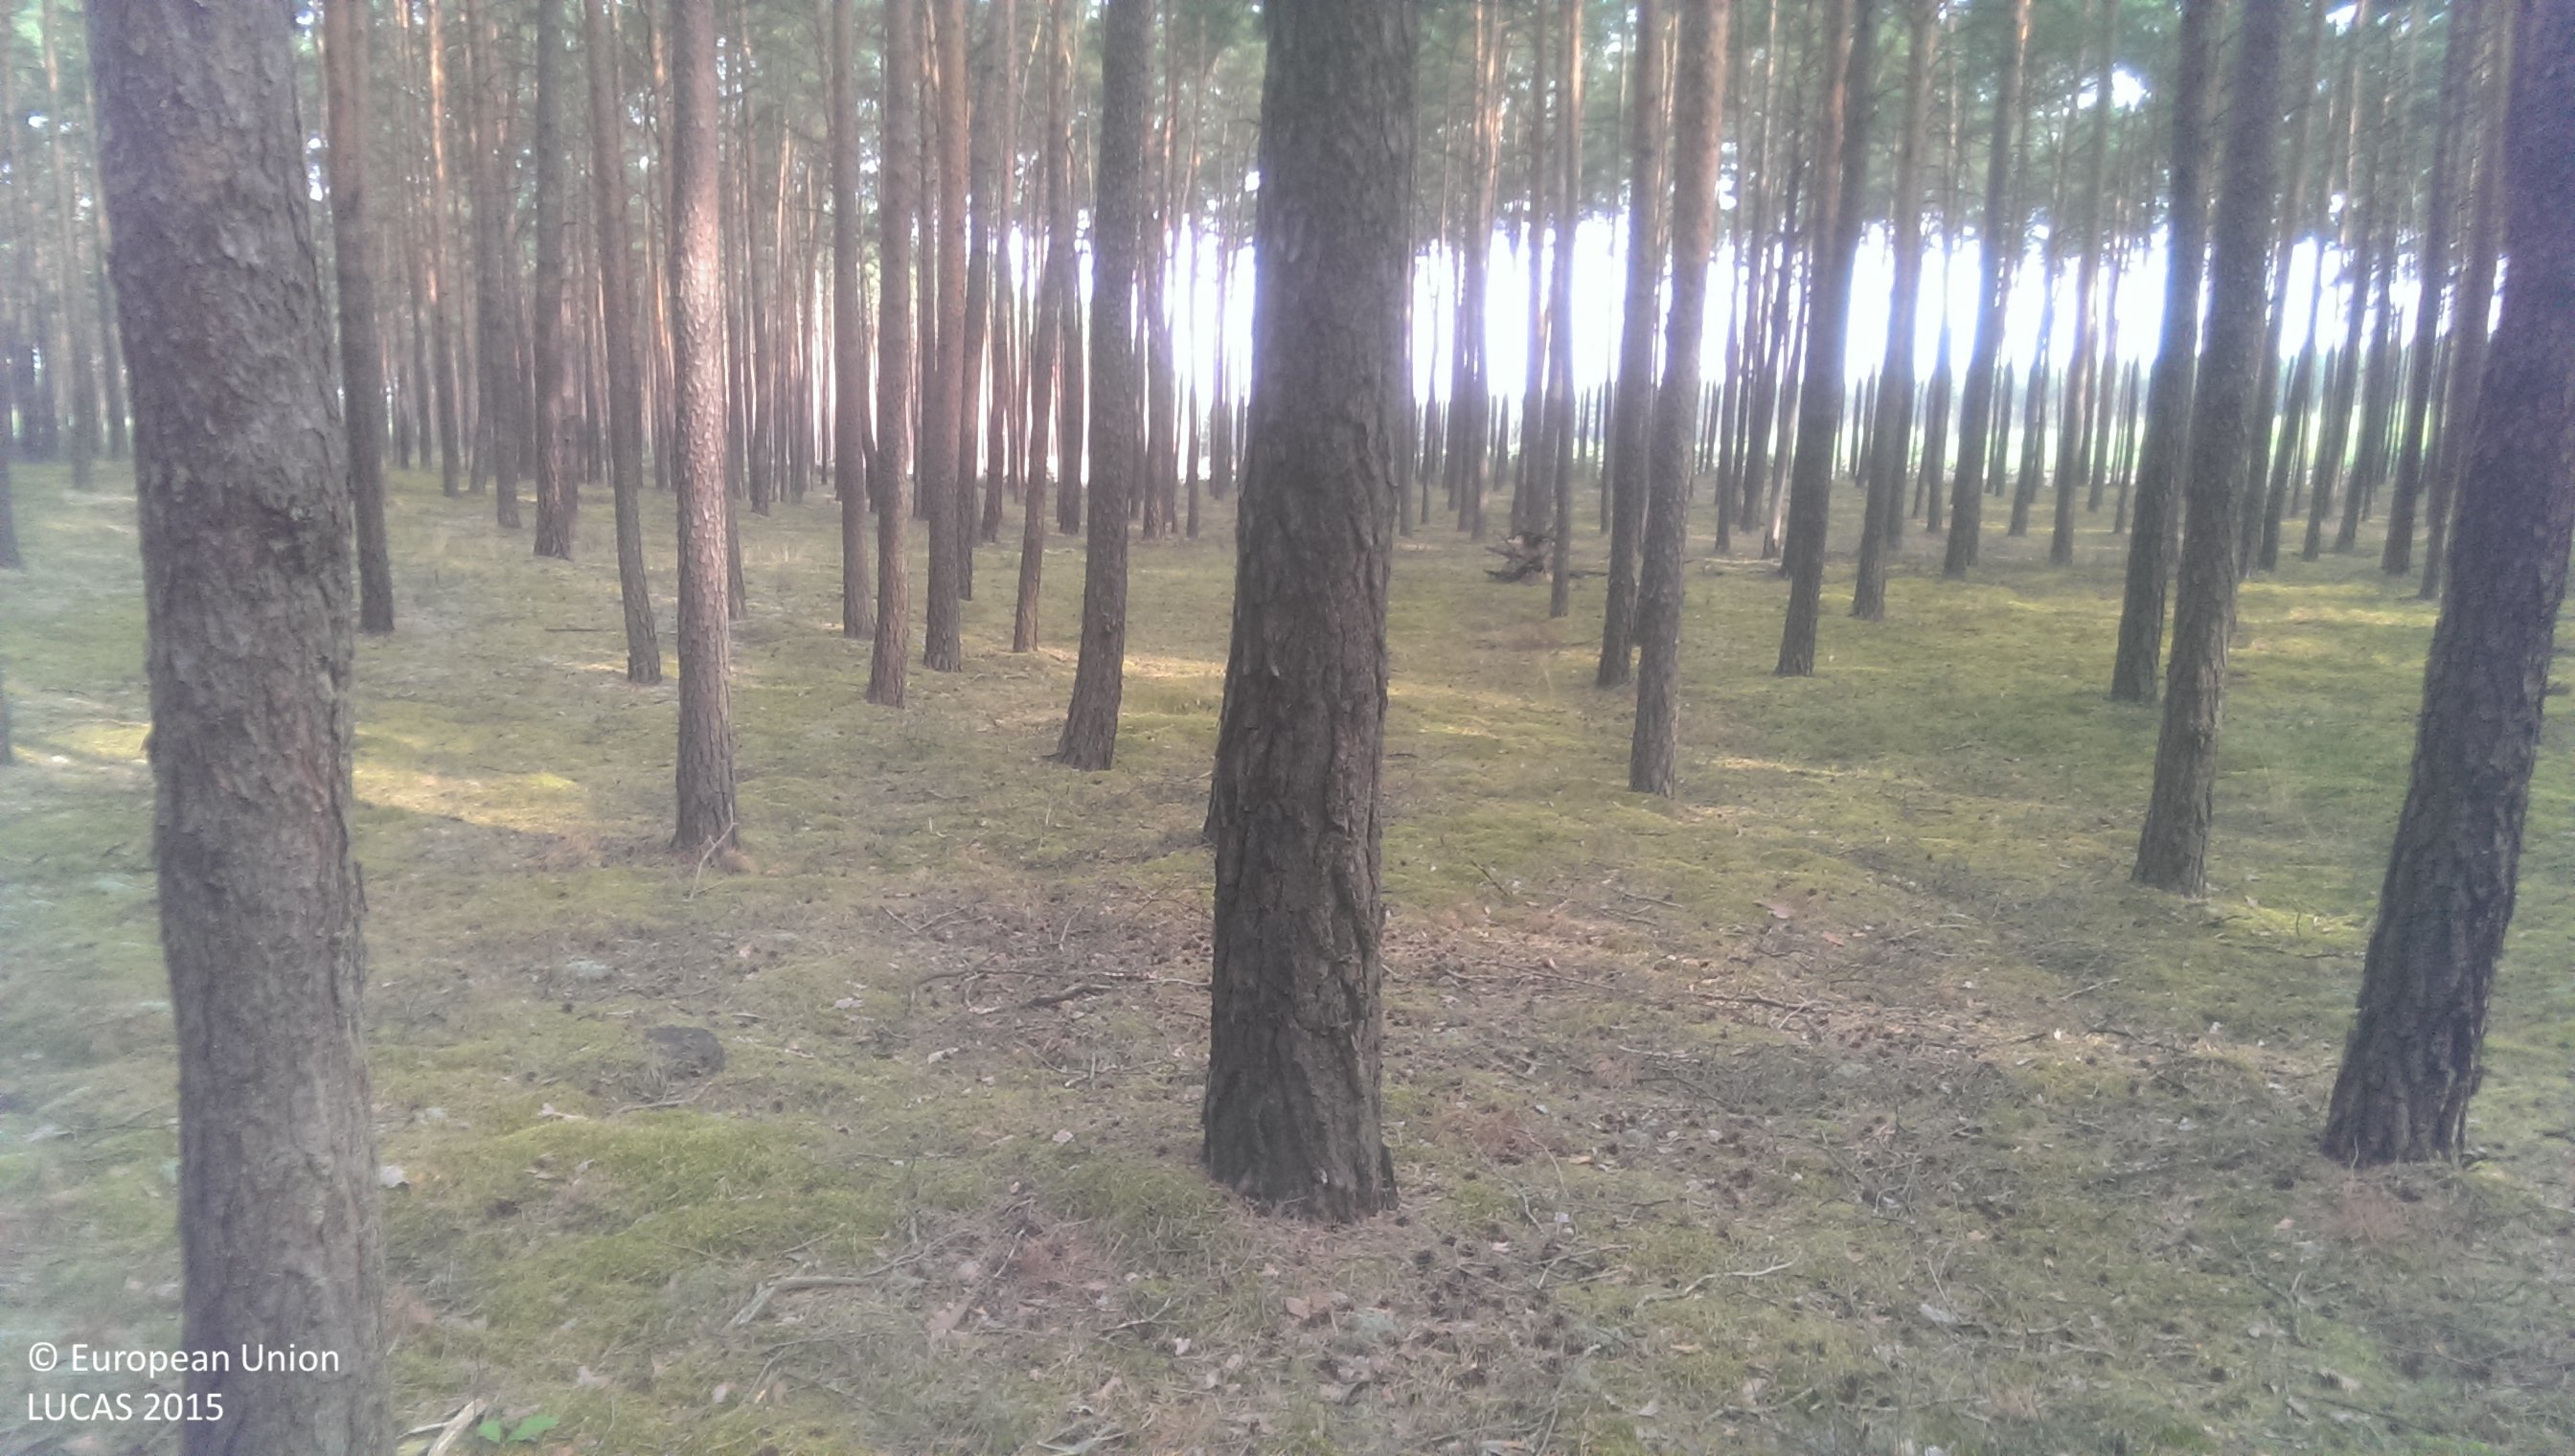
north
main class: Woodland
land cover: Pine dominated coniferous woodland
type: hemiboreal forest and nemoral coniferous forest and mixed broadleaved-coniferous forest
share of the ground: > 75 %
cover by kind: coniferous forest trees 80 %, lichens and mosses 20 %
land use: Forestry
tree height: > 5 m
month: July
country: PL
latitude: 52.4059
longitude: 15.6342
